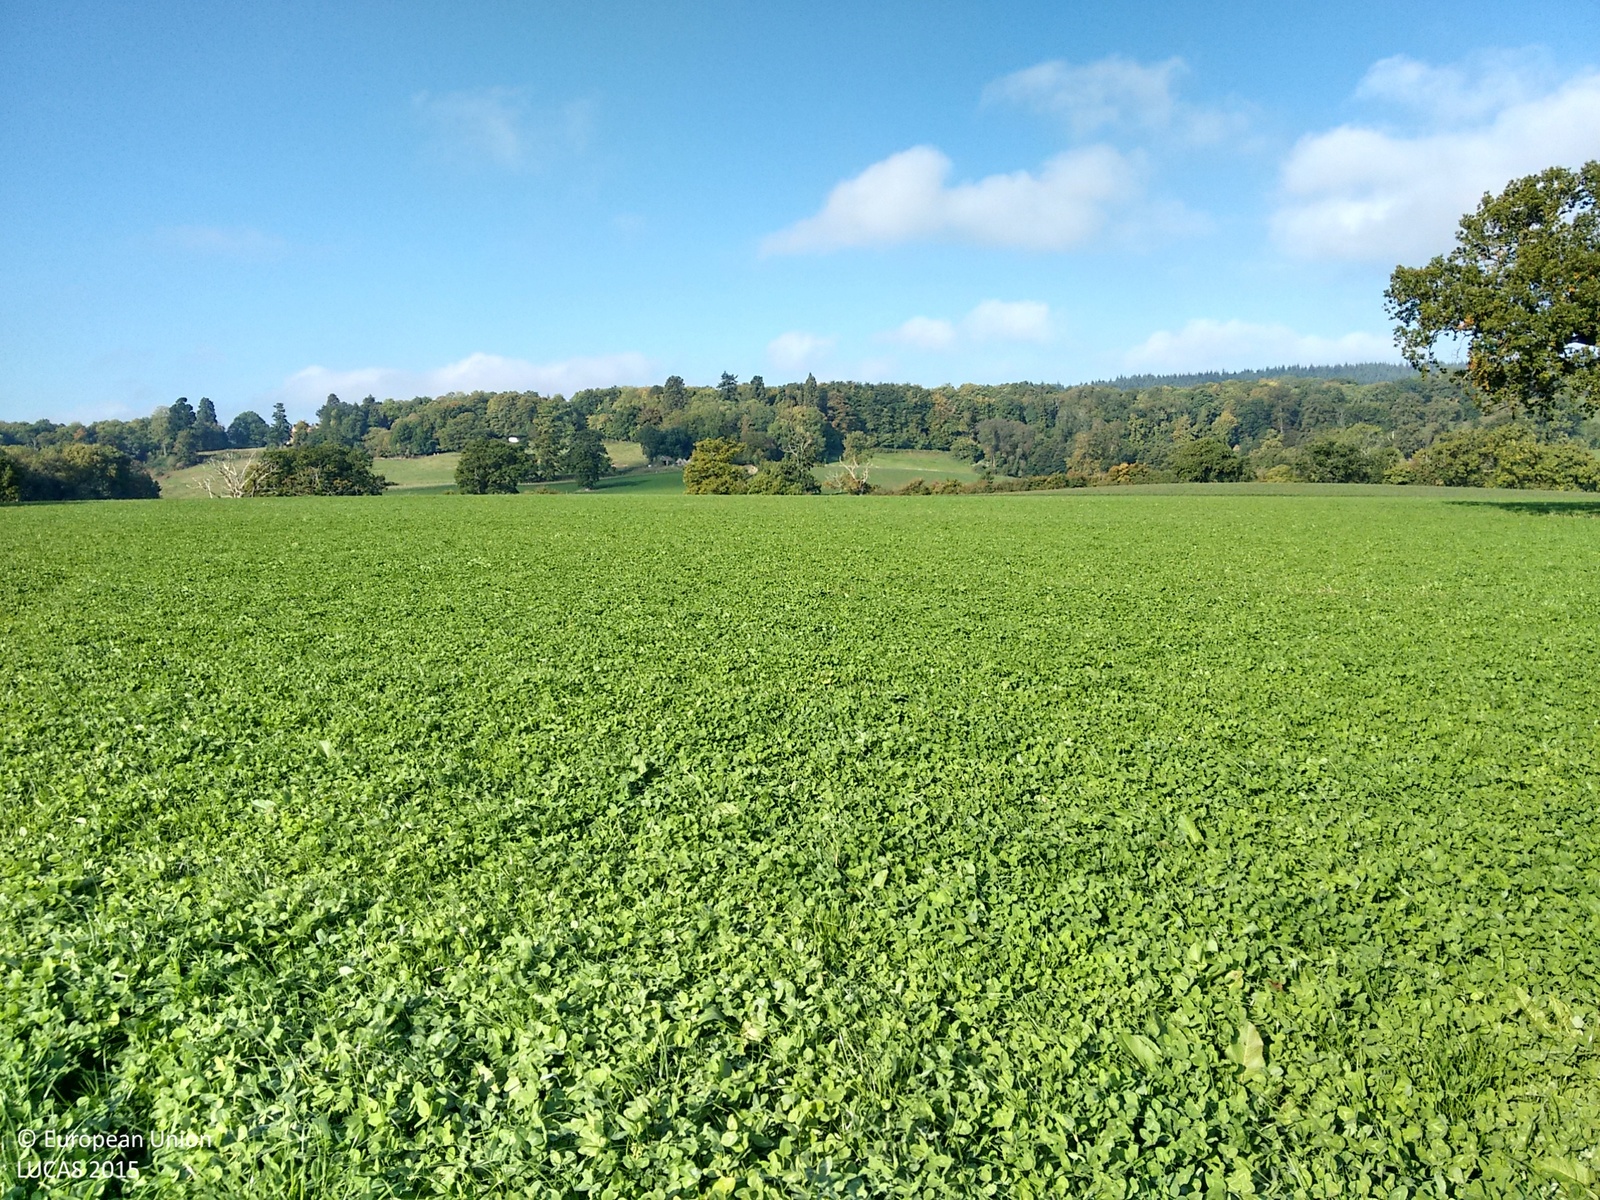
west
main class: Cropland
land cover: Clovers
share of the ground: > 75 %
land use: Agriculture (excluding fallow land and kitchen gardens)
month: September
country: GB
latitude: 51.7904
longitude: -2.4617
